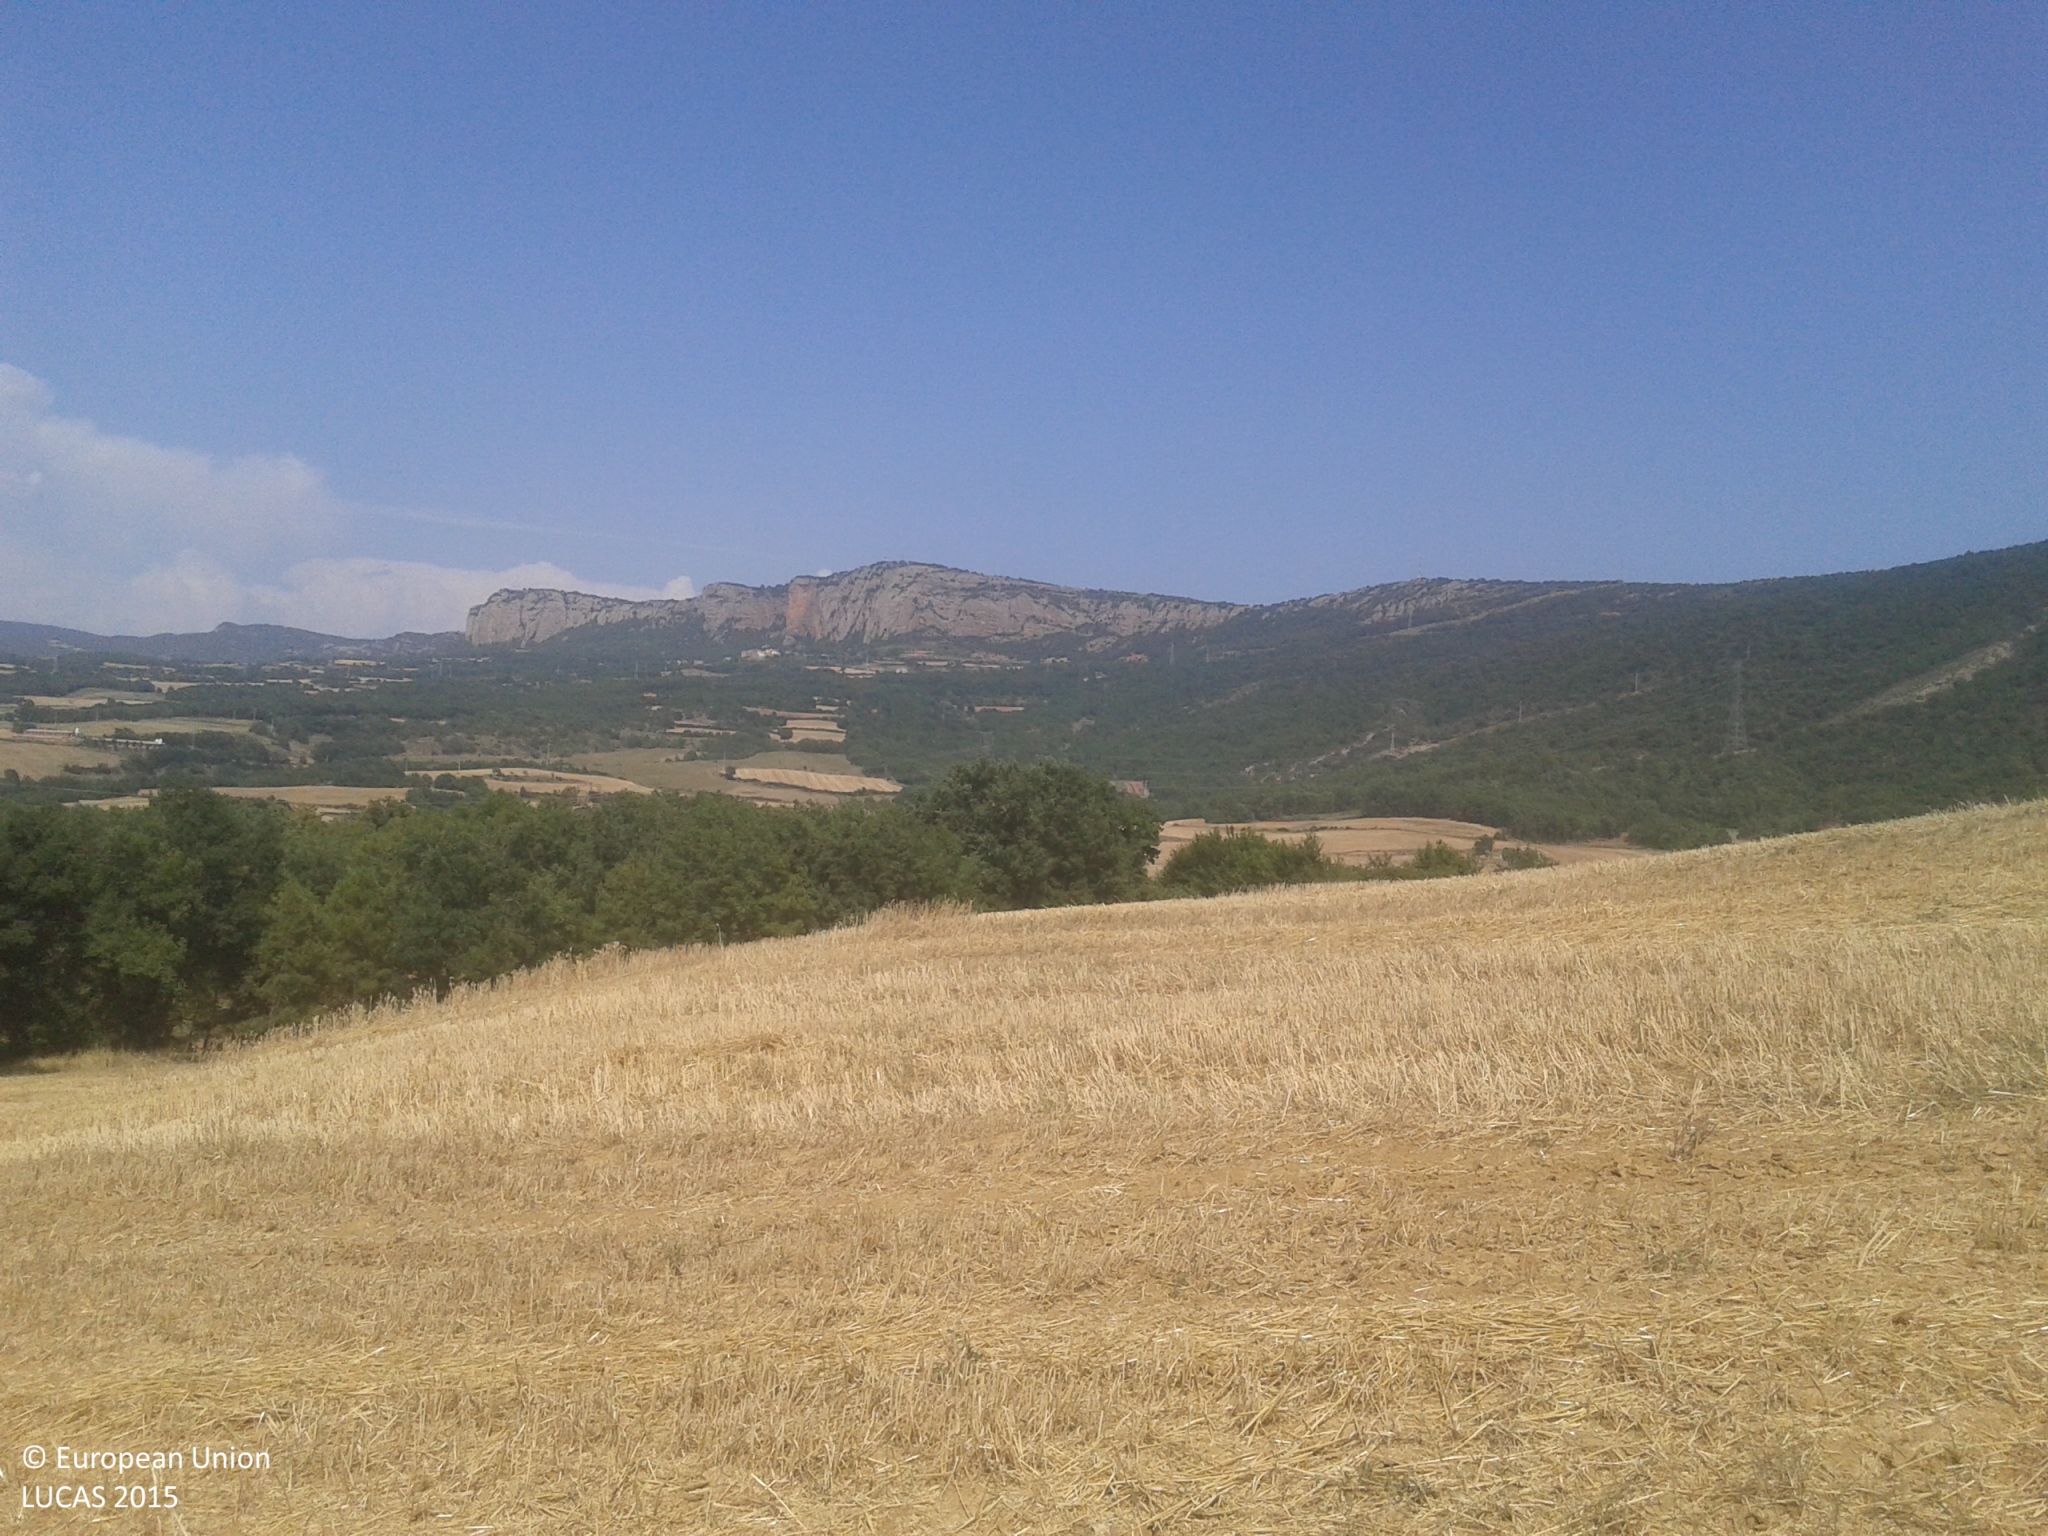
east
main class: Cropland
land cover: Common wheat
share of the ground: < 10 %
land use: Agriculture (excluding fallow land and kitchen gardens)
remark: Harvested field
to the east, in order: Common wheat; Grass margins; Barley; Groves; Tracks; Grass margins; Rape and turnip rape; Grassland with sparse tree/shrub cover
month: July
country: ES
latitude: 42.0579
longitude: 1.0563
